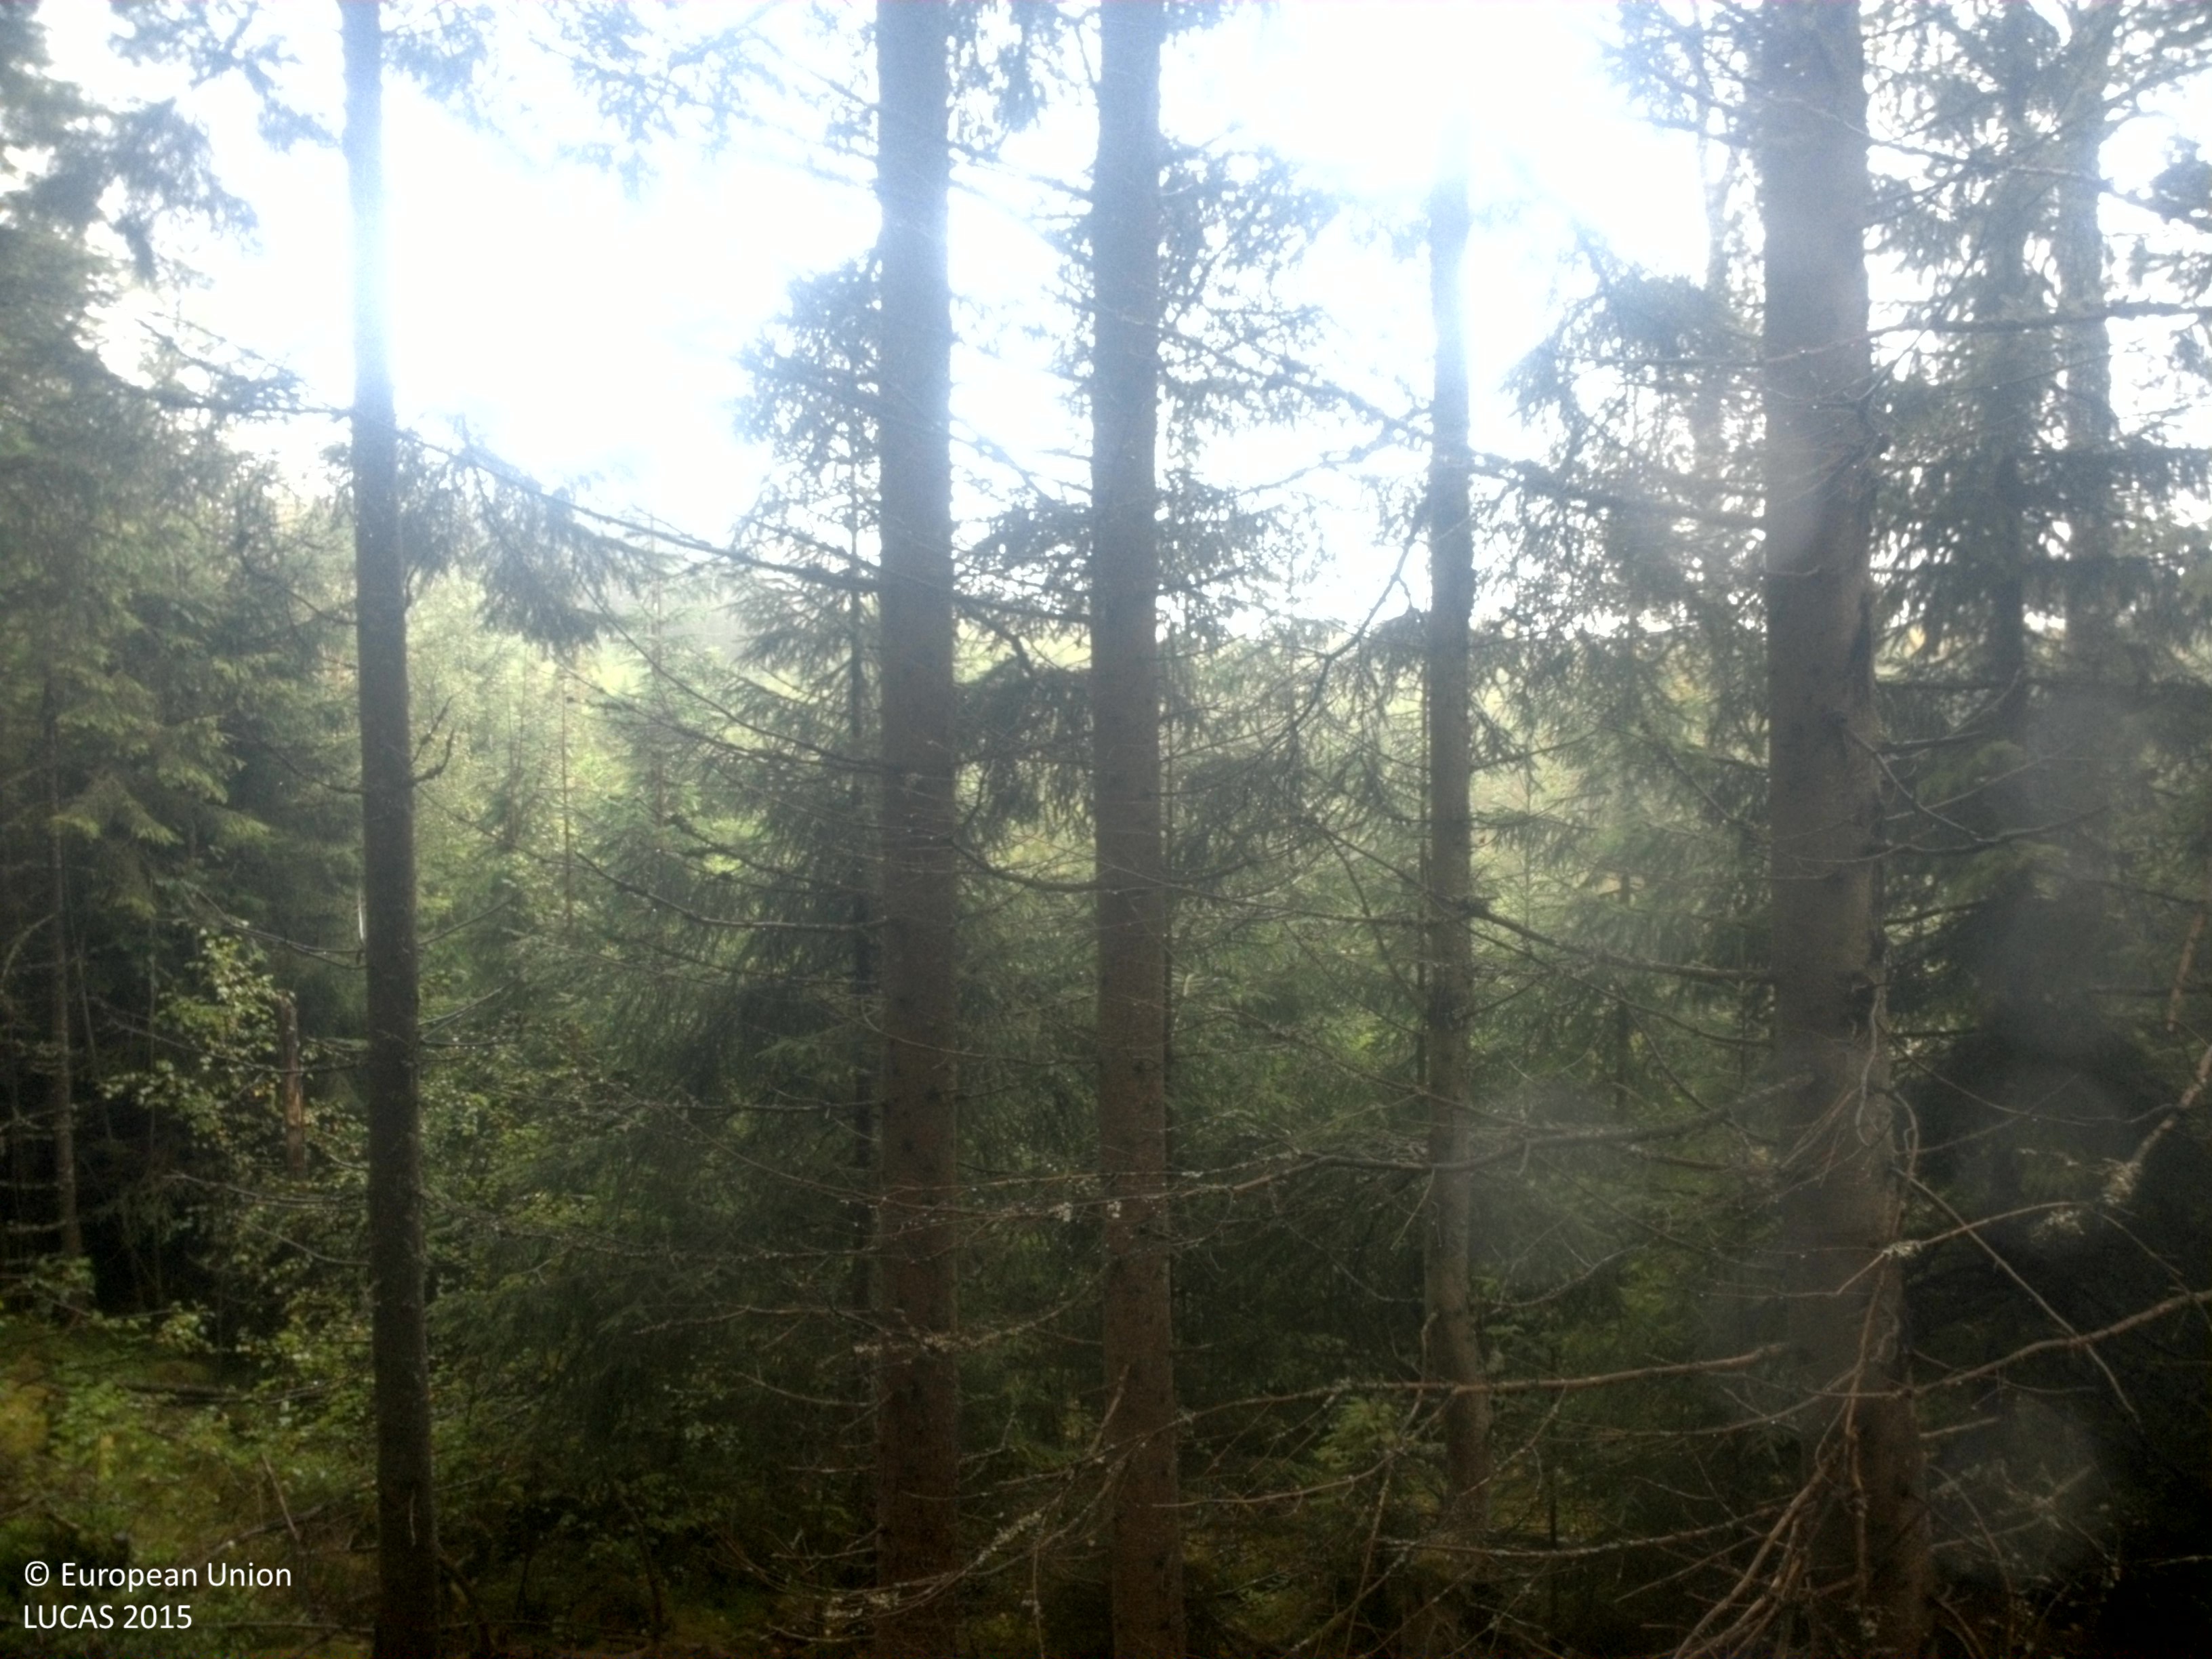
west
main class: Woodland
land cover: Spruce dominated coniferous woodland
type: boreal forest
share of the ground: 50 - 75 %
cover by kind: coniferous forest trees 60 %, lichens and mosses 20 %, herbaceous plants 10 %, broadleaved forest trees 5 %, shrubs 5 %
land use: Forestry
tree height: > 5 m
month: August
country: SE
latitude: 57.7298
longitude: 13.2699
